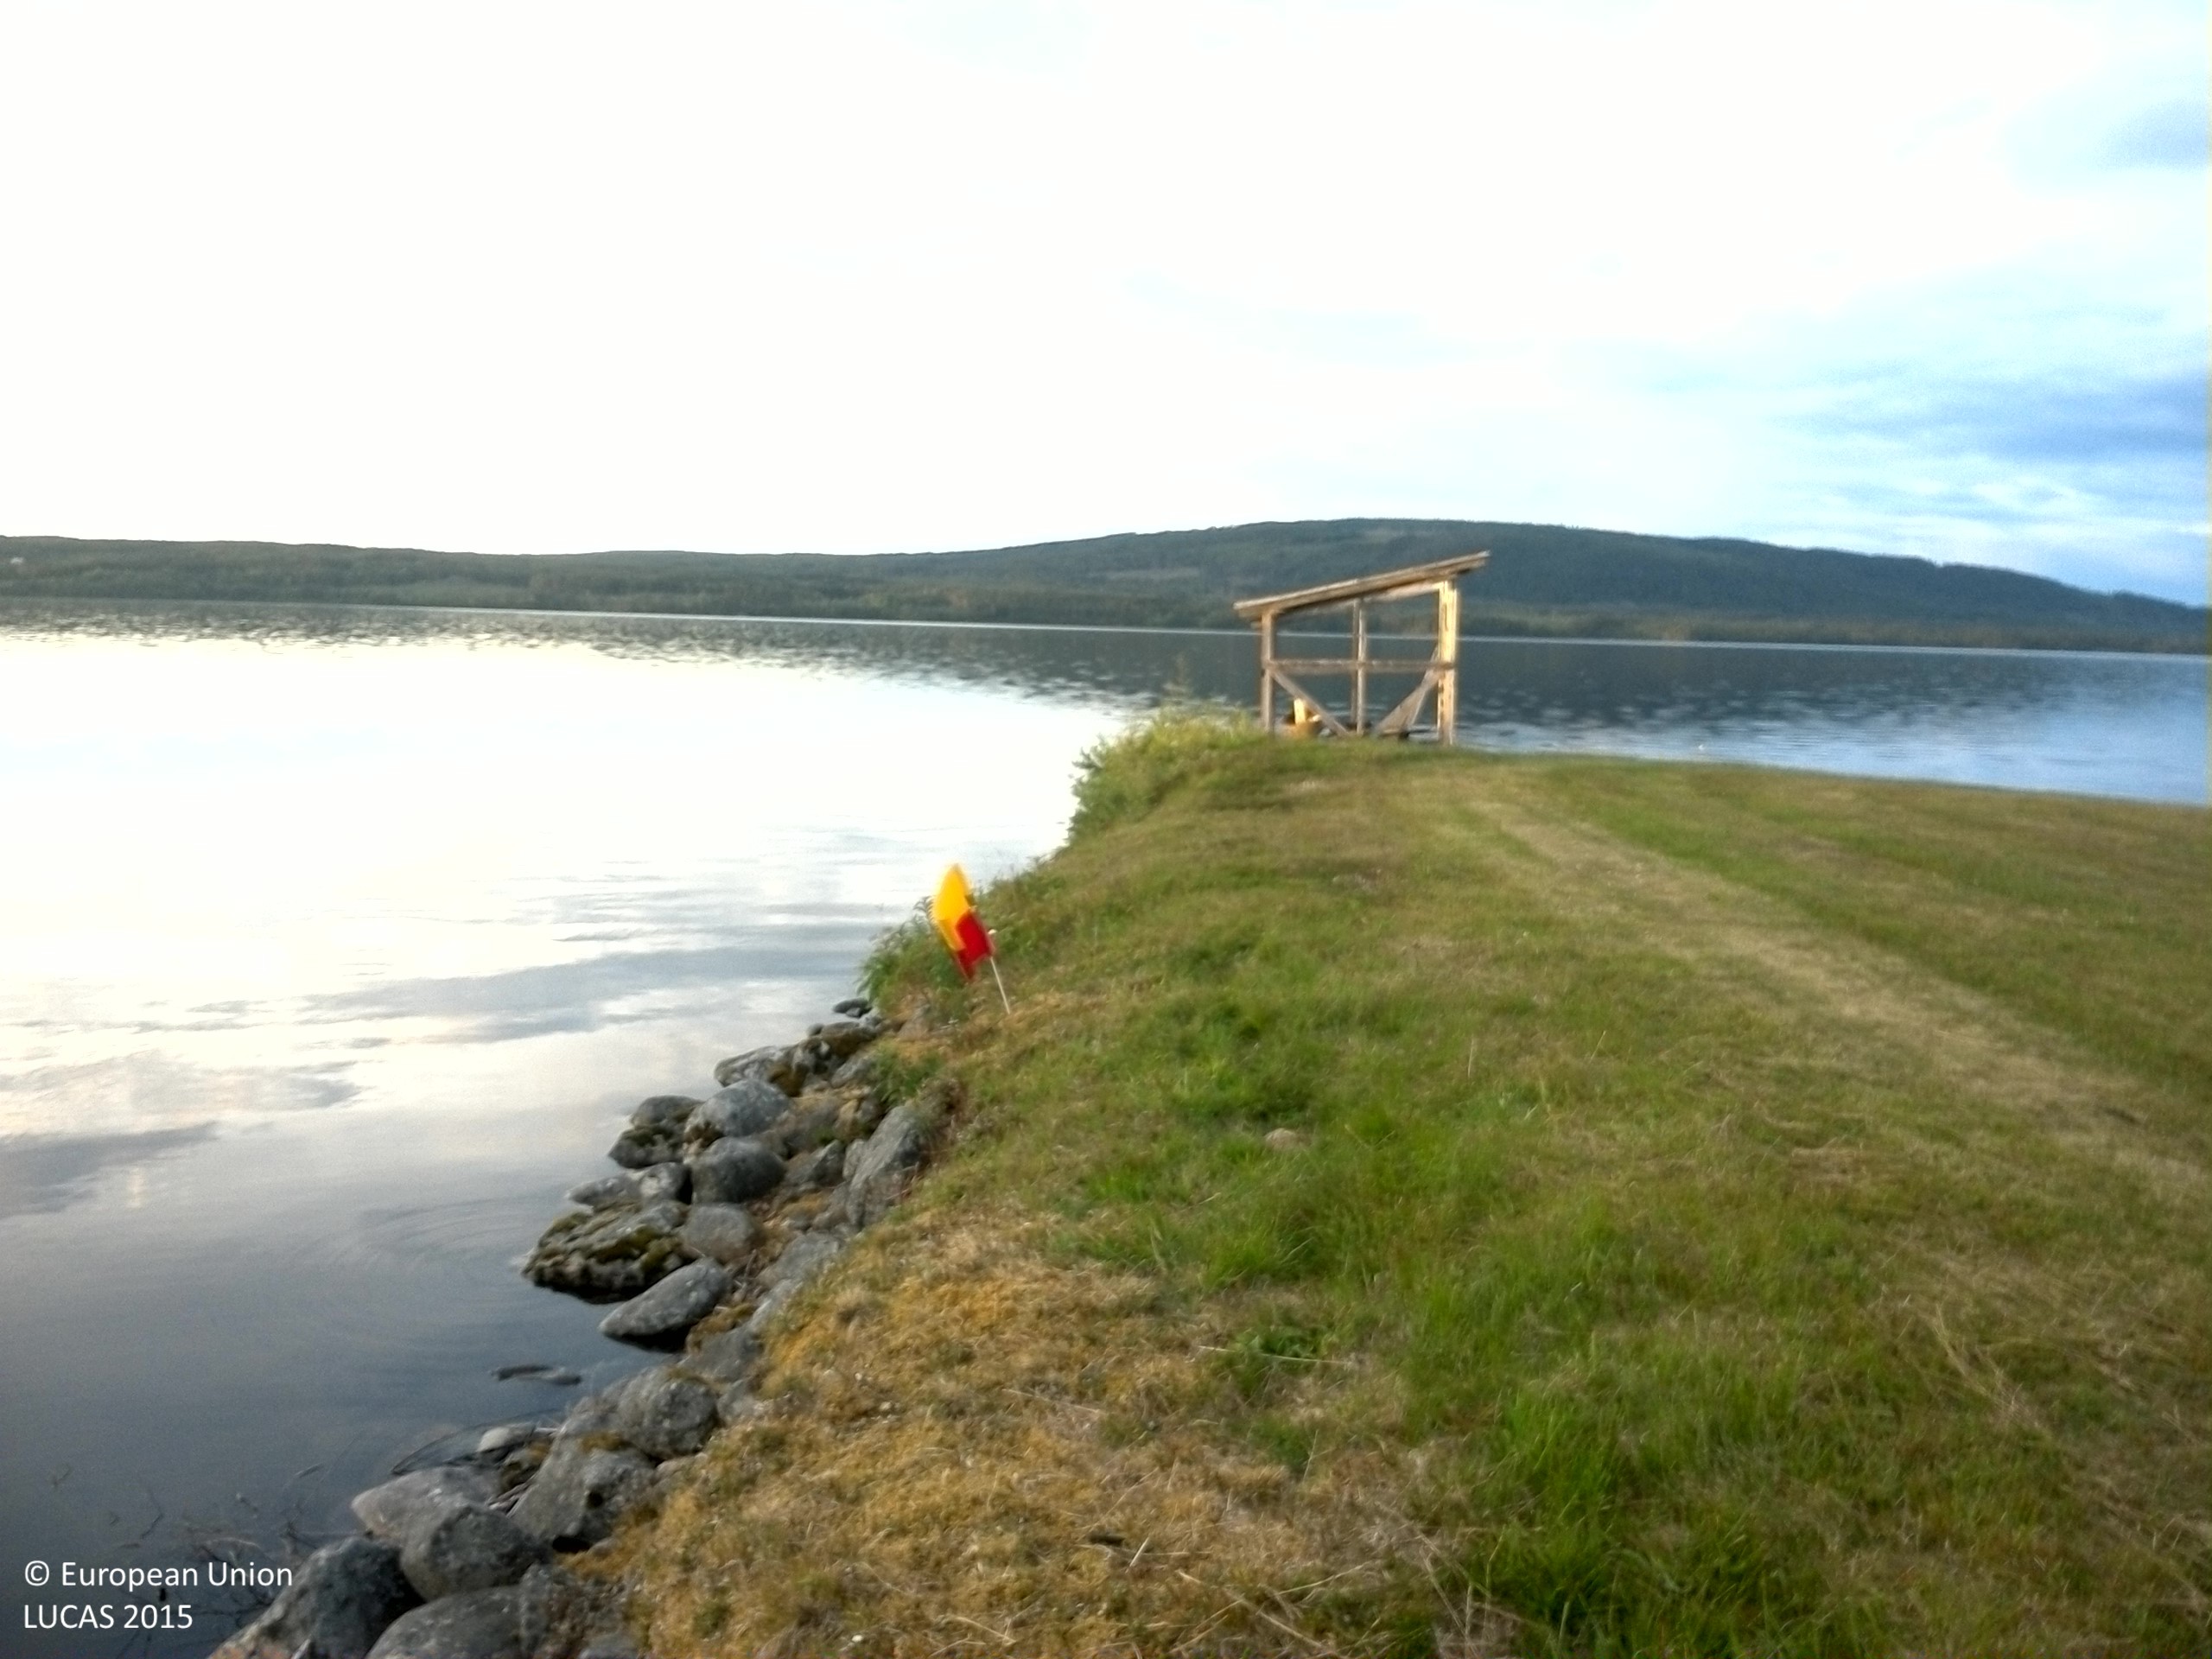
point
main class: Grassland
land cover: Grassland without tree/shrub cover
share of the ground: > 75 %
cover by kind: herbaceous plants 100 %
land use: Residential
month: July
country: SE
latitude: 64.3932
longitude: 16.0040
